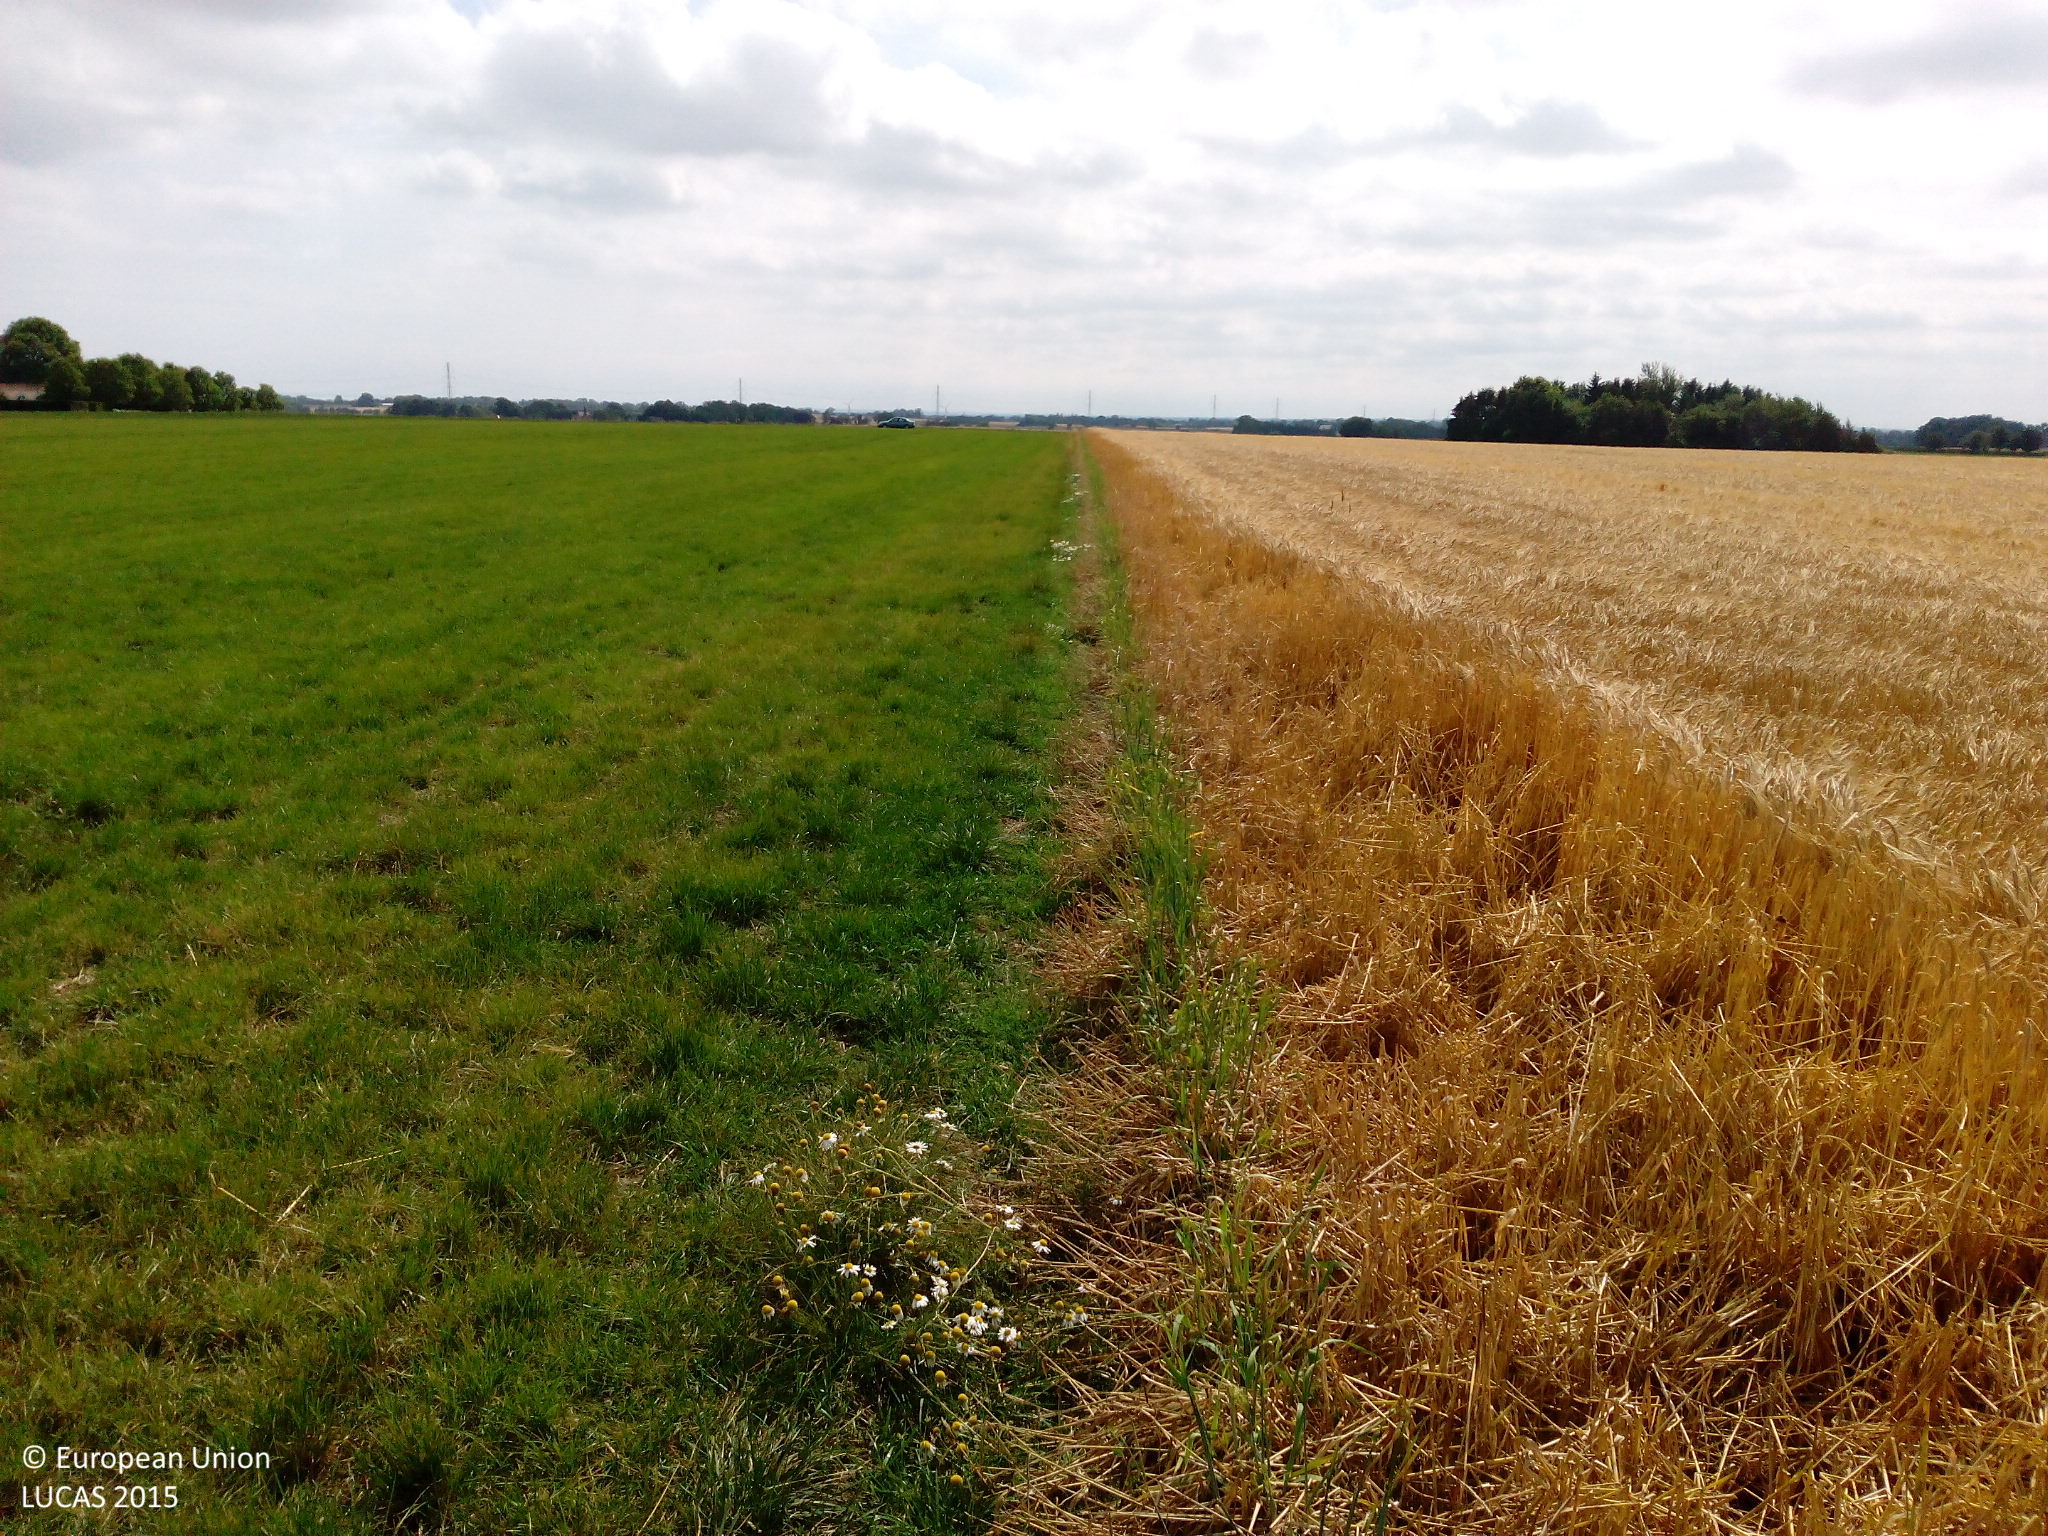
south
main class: Cropland
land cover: Barley
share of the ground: > 75 %
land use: Agriculture (excluding fallow land and kitchen gardens)
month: August
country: DK
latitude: 55.5760
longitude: 12.1712
